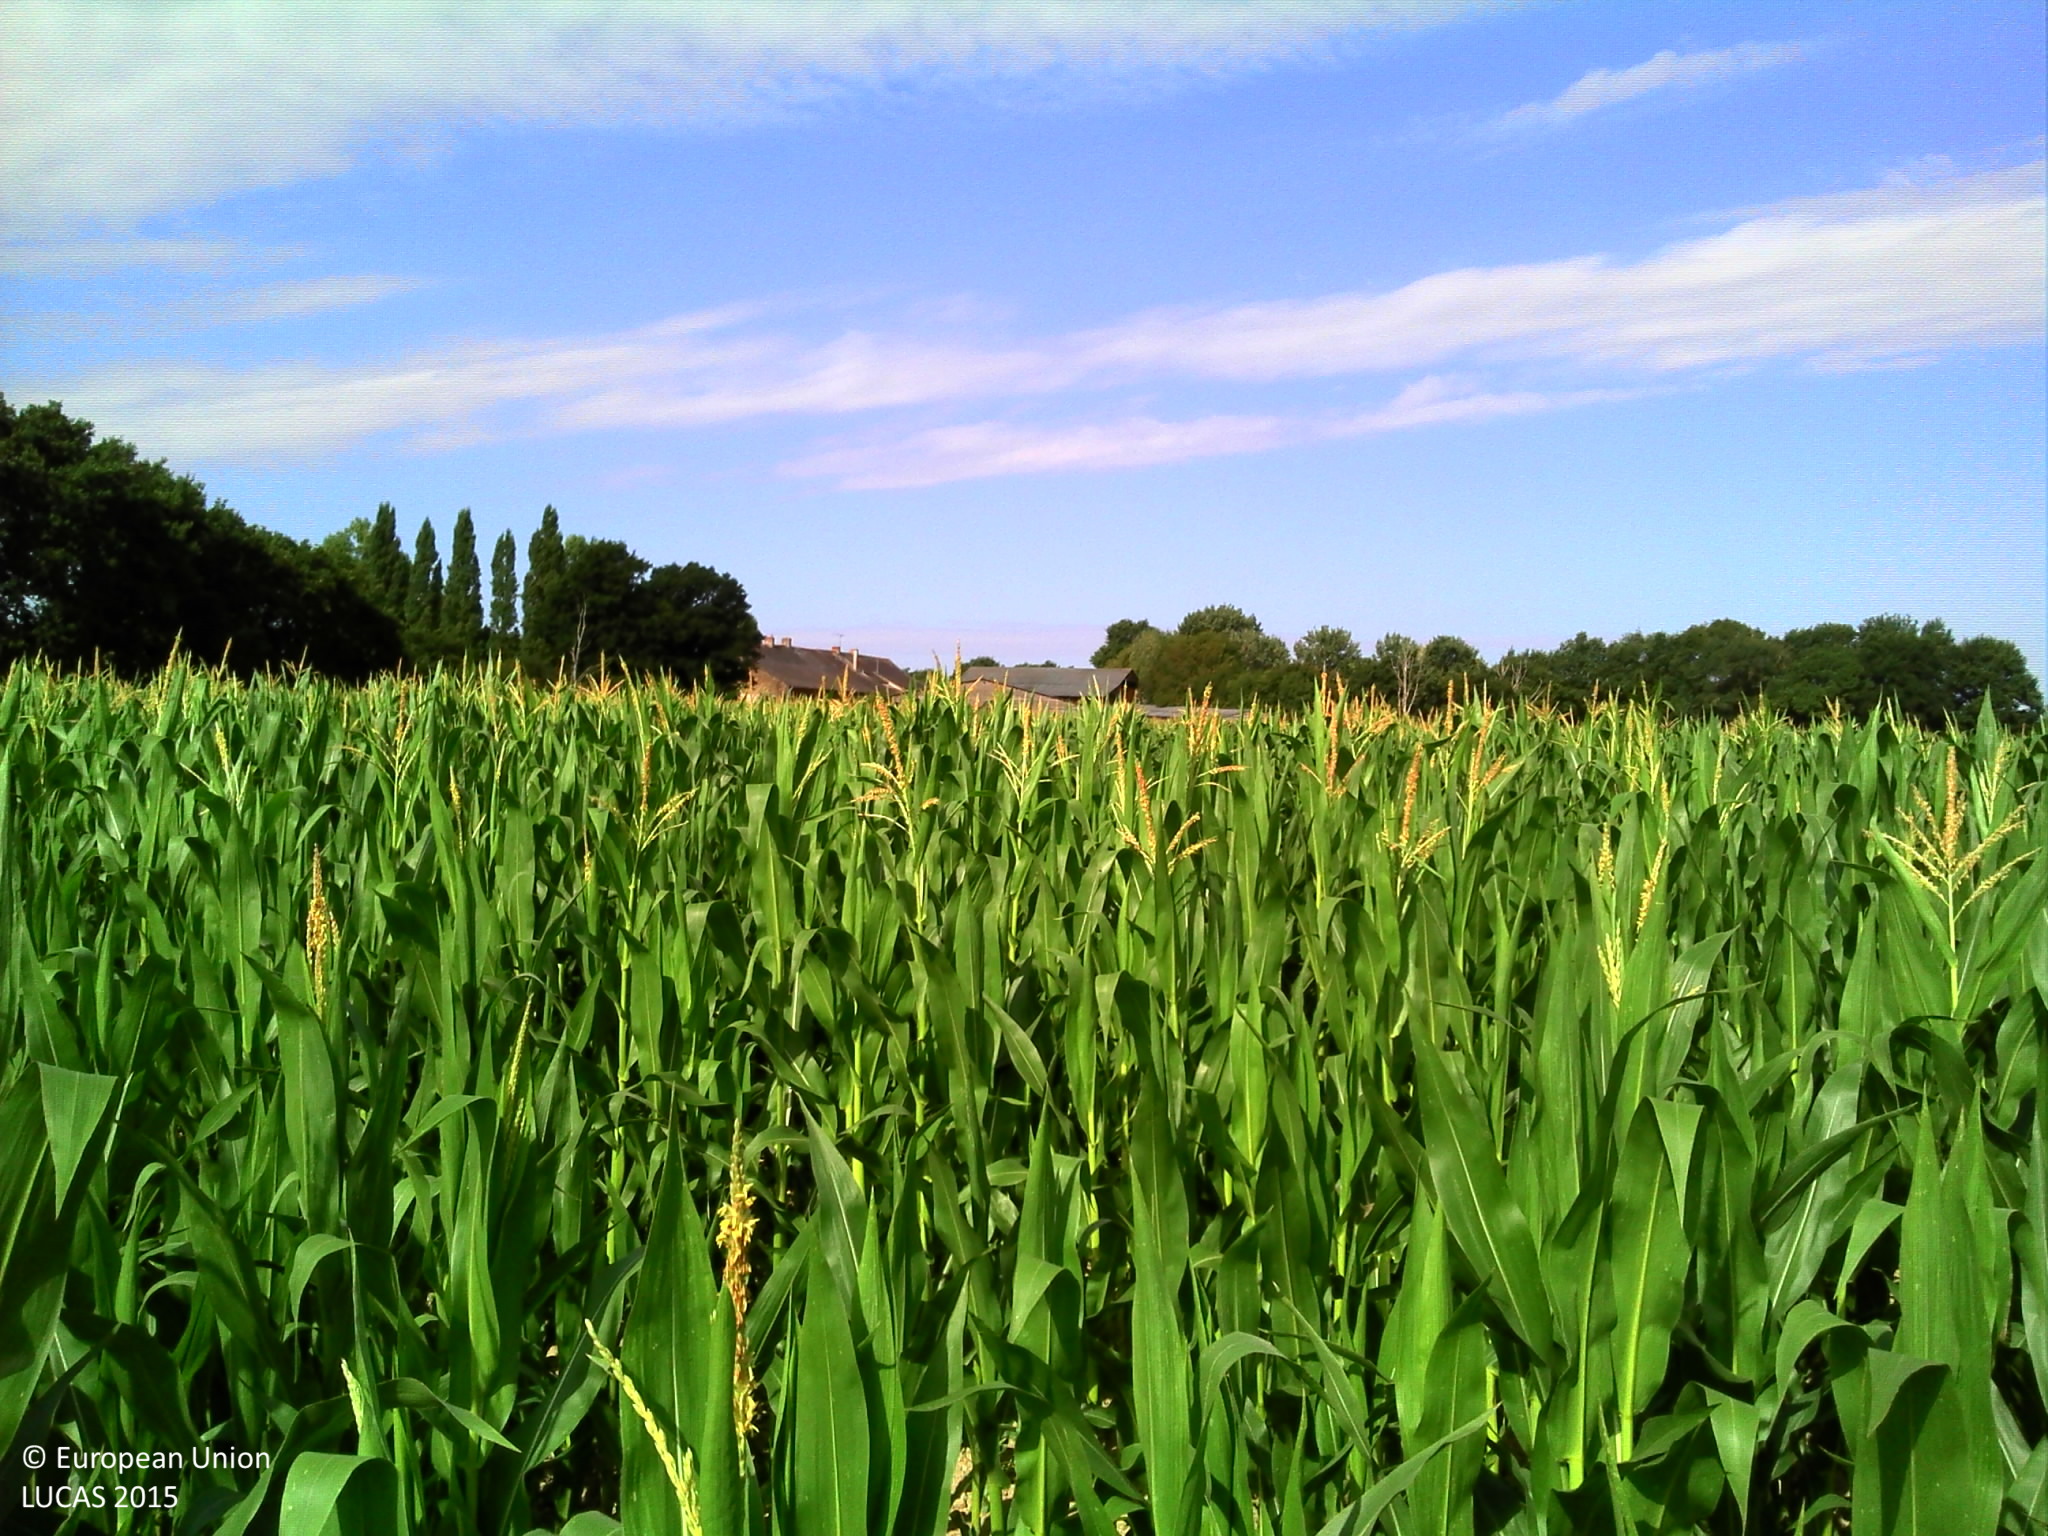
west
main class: Cropland
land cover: Maize
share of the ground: 25 - 50 %
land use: Agriculture (excluding fallow land and kitchen gardens)
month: August
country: FR
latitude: 47.4260
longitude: -1.7783
